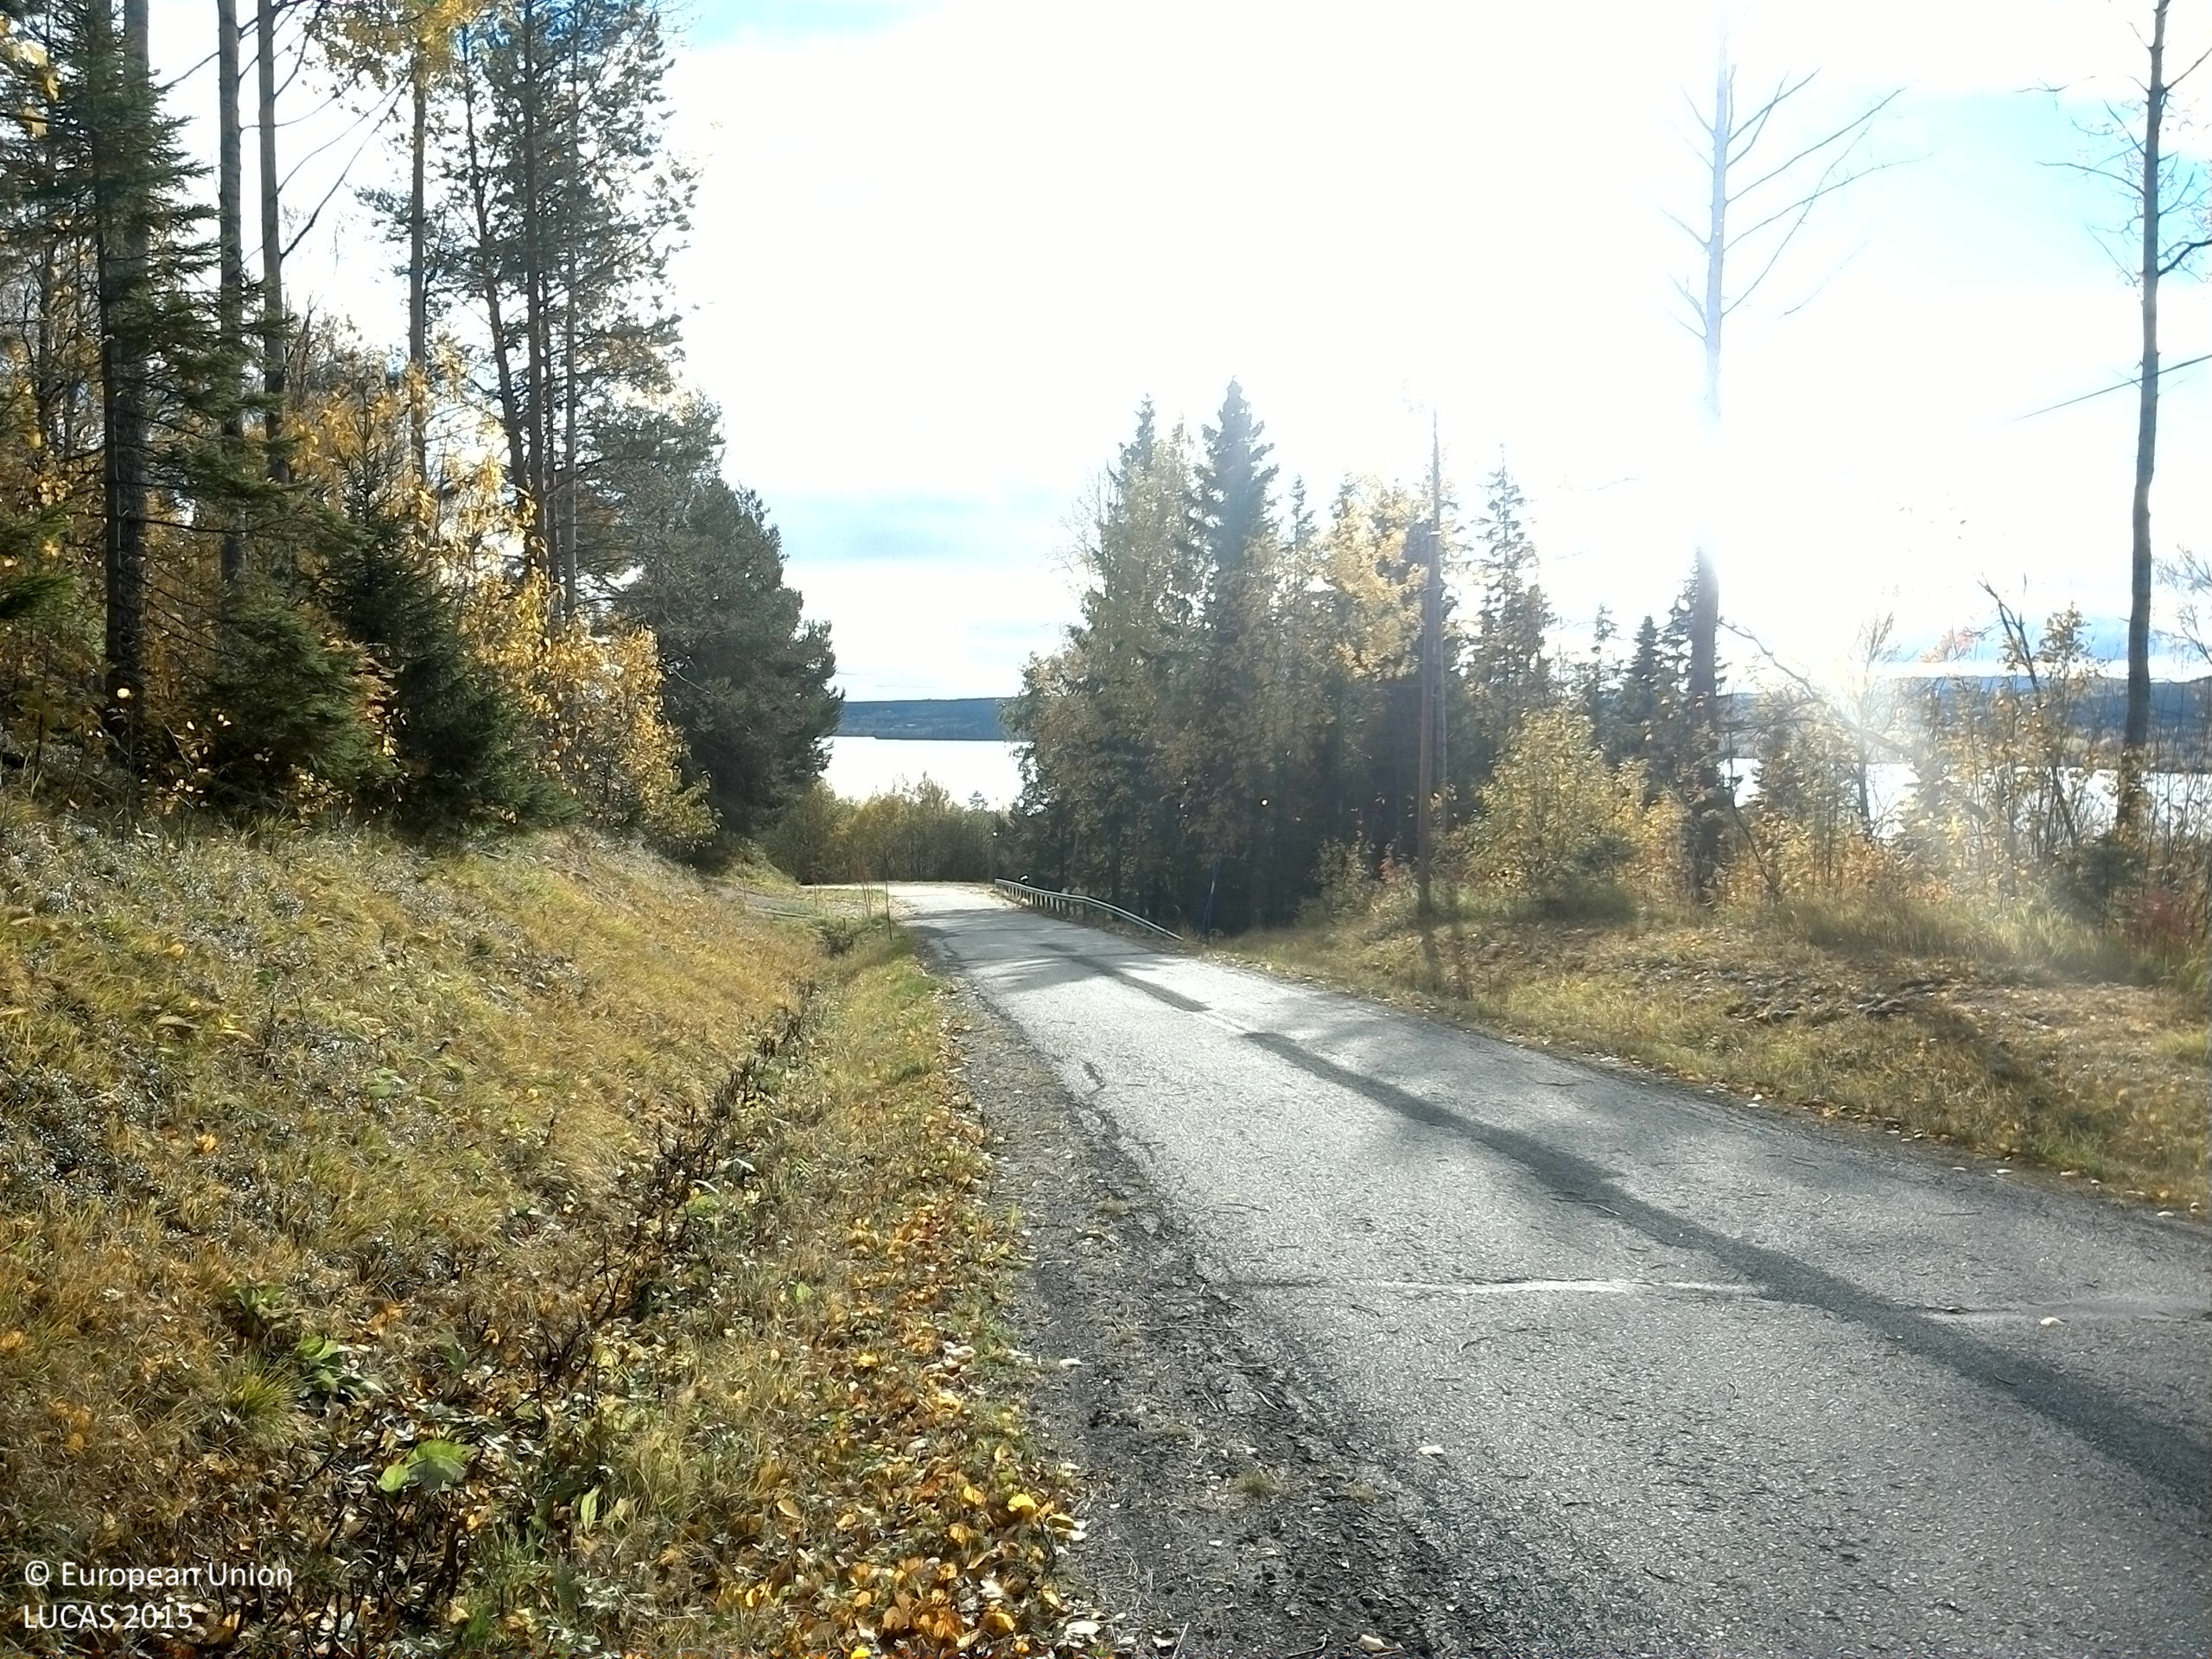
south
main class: Woodland
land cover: Broadleaved woodland
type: boreal forest
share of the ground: 50 - 75 %
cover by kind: broadleaved forest trees 60 %, herbaceous plants 30 %, shrubs 5 %, lichens and mosses 5 %
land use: Forestry
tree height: < 5 m
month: October
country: SE
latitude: 64.2345
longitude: 15.8881
